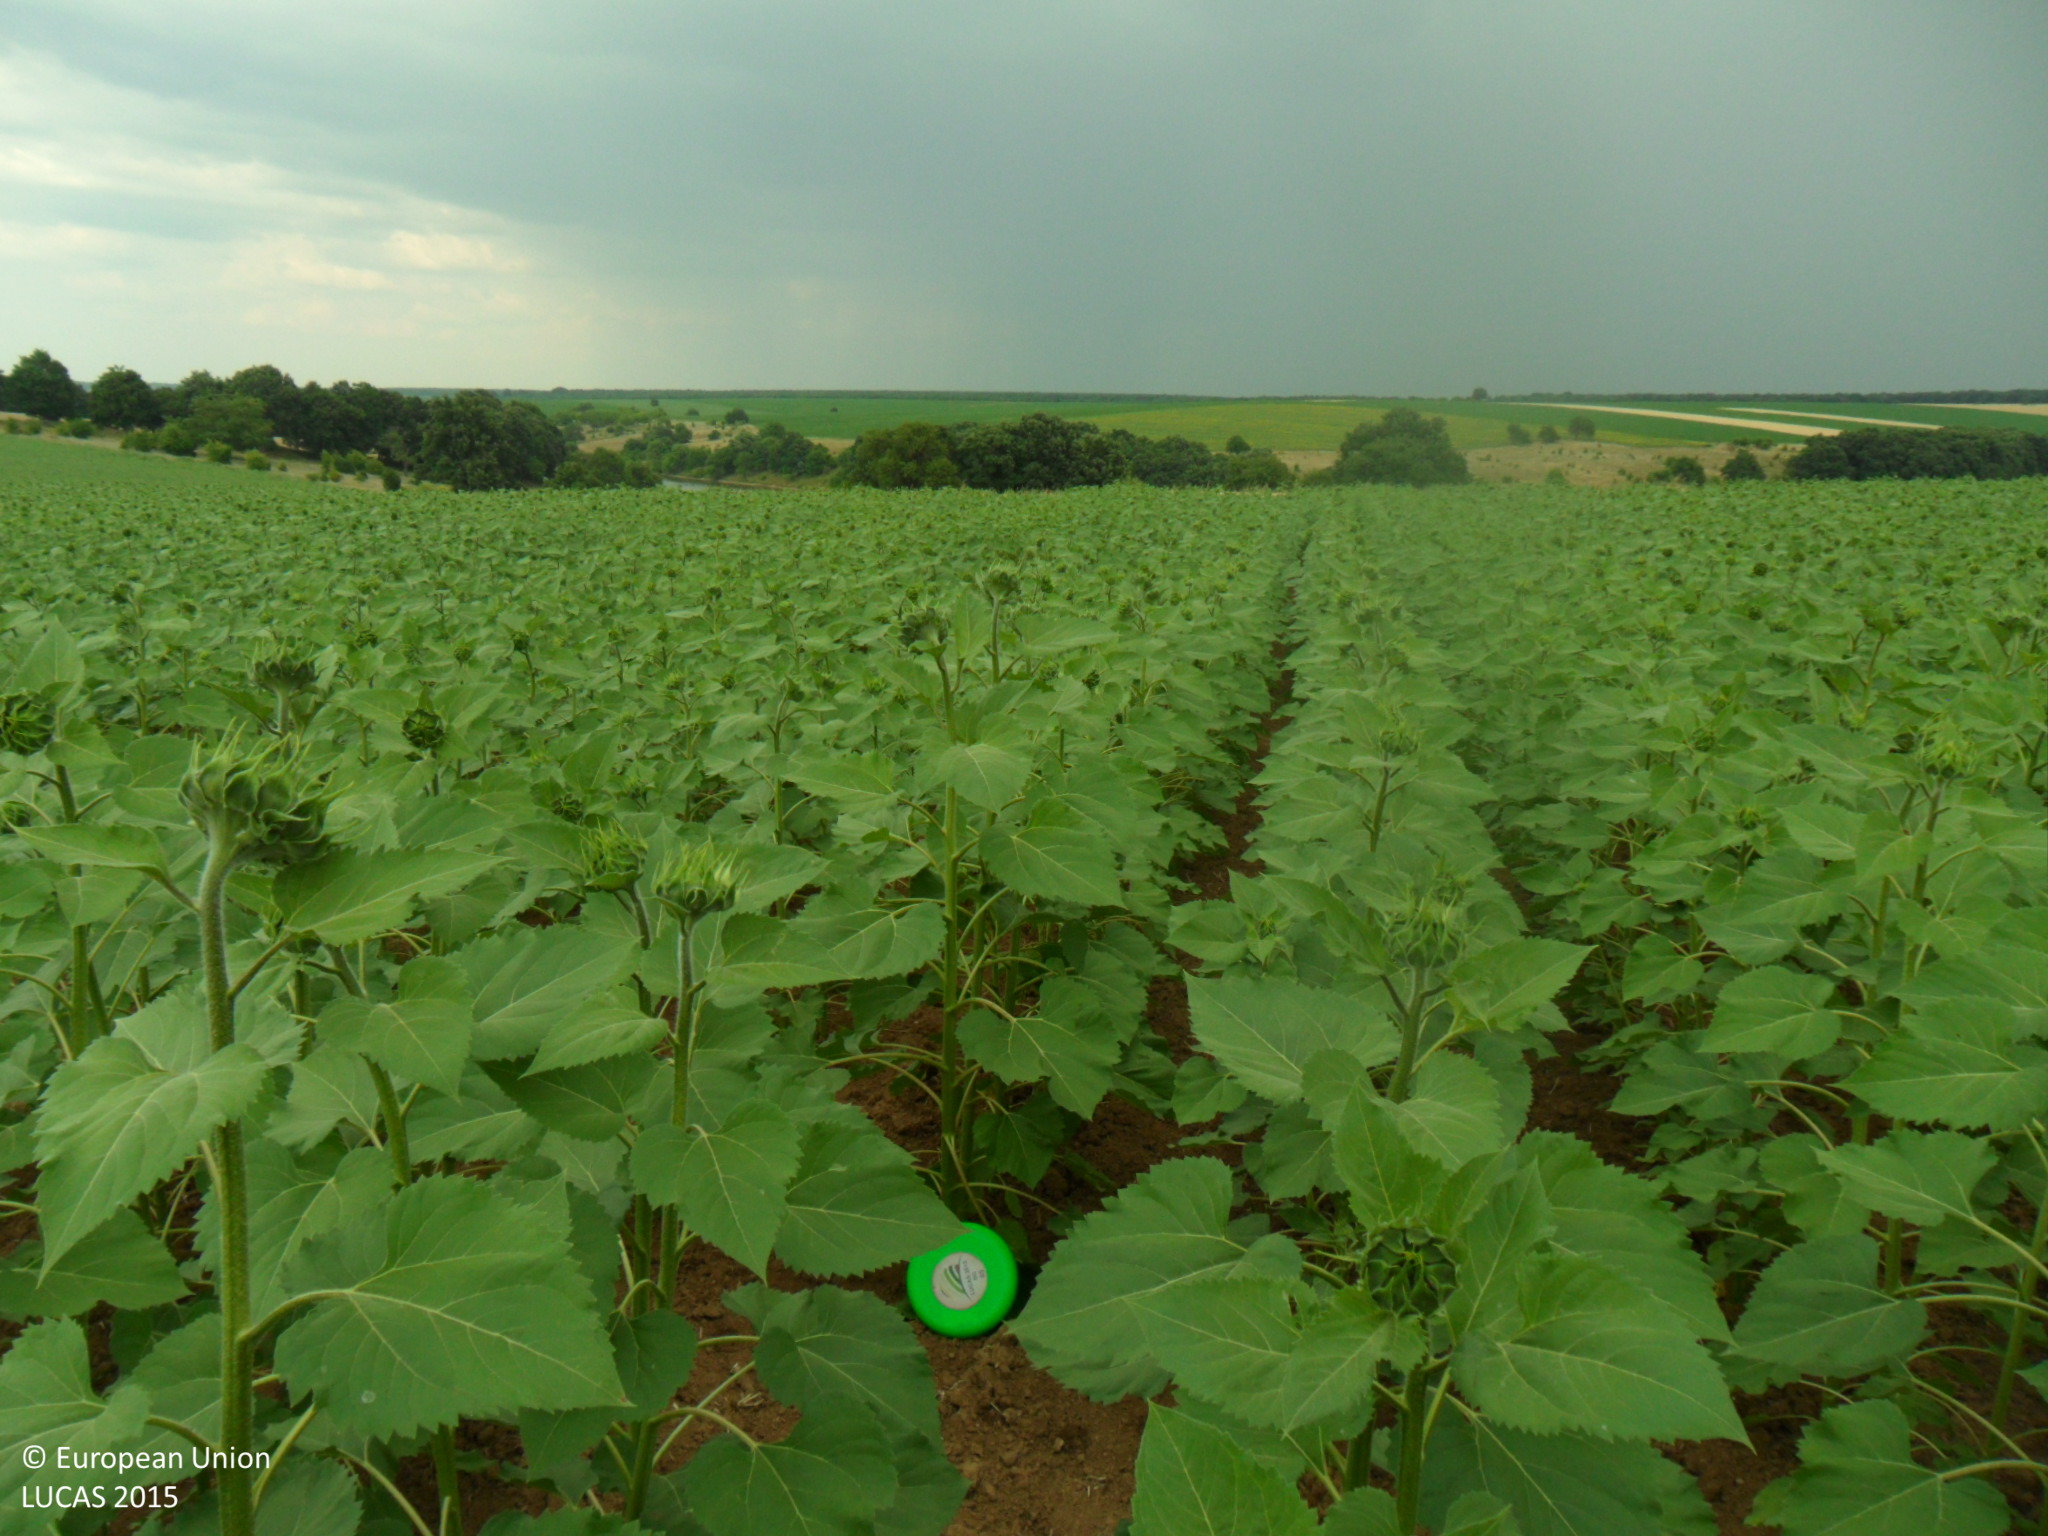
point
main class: Cropland
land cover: Sunflower
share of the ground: > 75 %
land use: Agriculture (excluding fallow land and kitchen gardens)
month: July
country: BG
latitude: 43.6040
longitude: 26.8520
